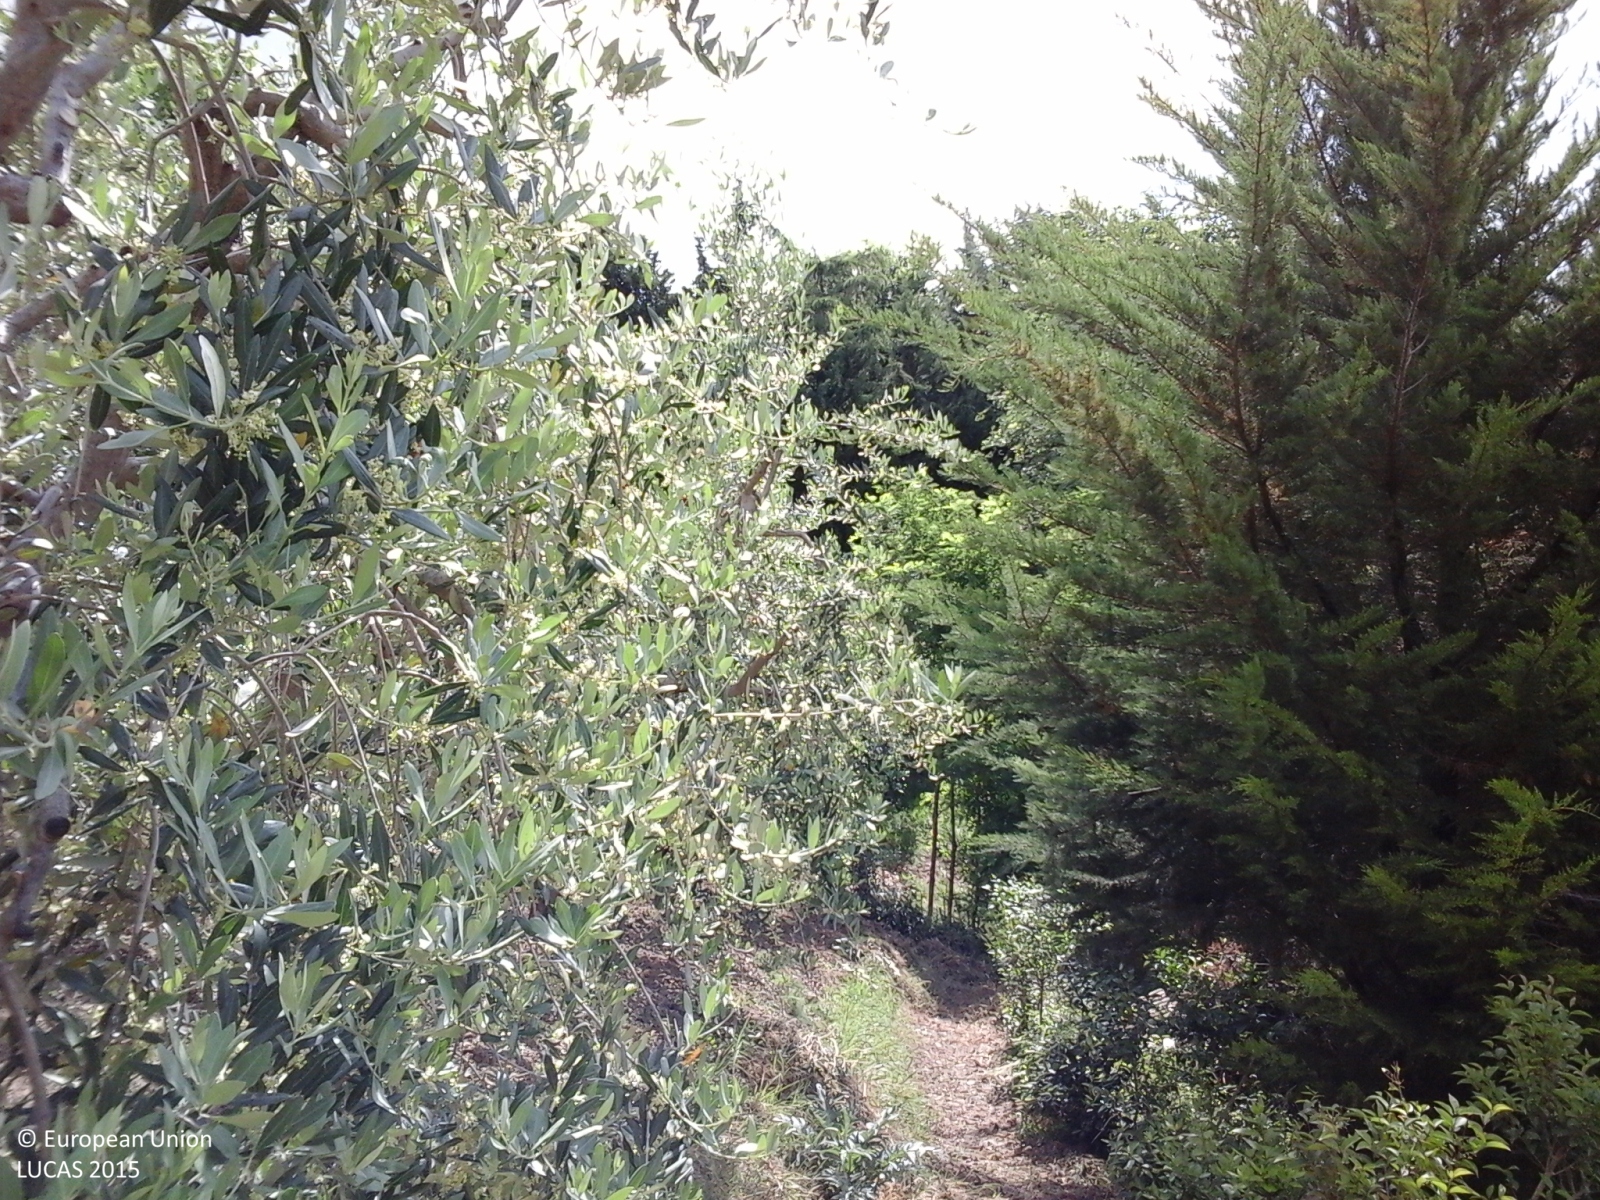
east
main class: Cropland
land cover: Olive groves
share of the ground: > 75 %
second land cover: Grassland without tree/shrub cover
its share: > 75 %
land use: Agriculture (excluding fallow land and kitchen gardens)
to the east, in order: Olive groves; Grassland without tree/shrub cover; Broadleaved woodland; Grassland without tree/shrub cover; Lines of trees; Artificial constructions in urban areas; Spontaneously vegetated surfaces; Broadleaved woodland; Shrubland without tree cover
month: May
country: IT
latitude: 42.8603
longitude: 13.6248
